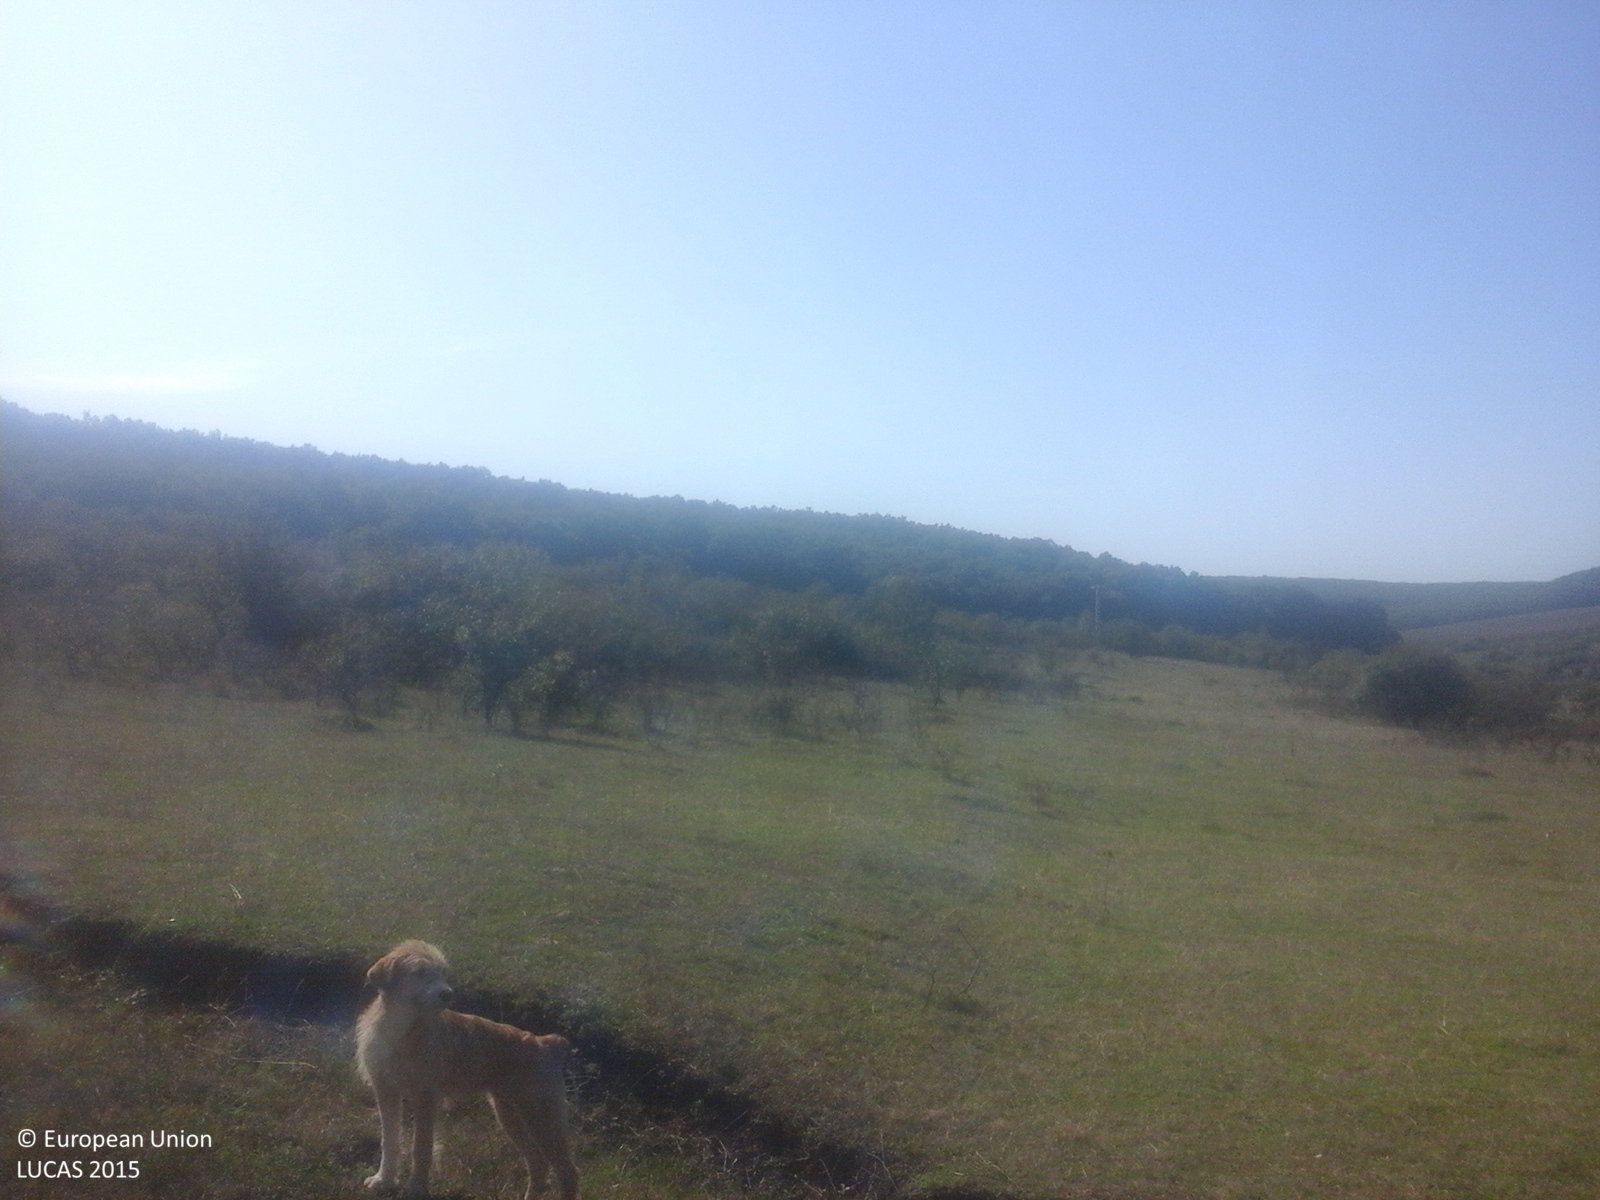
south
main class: Grassland
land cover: Grassland with sparse tree/shrub cover
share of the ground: > 75 %
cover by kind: herbaceous plants 85 %, shrubs 10 %, broadleaved forest trees 5 %
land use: Agriculture (excluding fallow land and kitchen gardens)
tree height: > 5 m
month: October
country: RO
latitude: 46.0110
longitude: 23.8511
